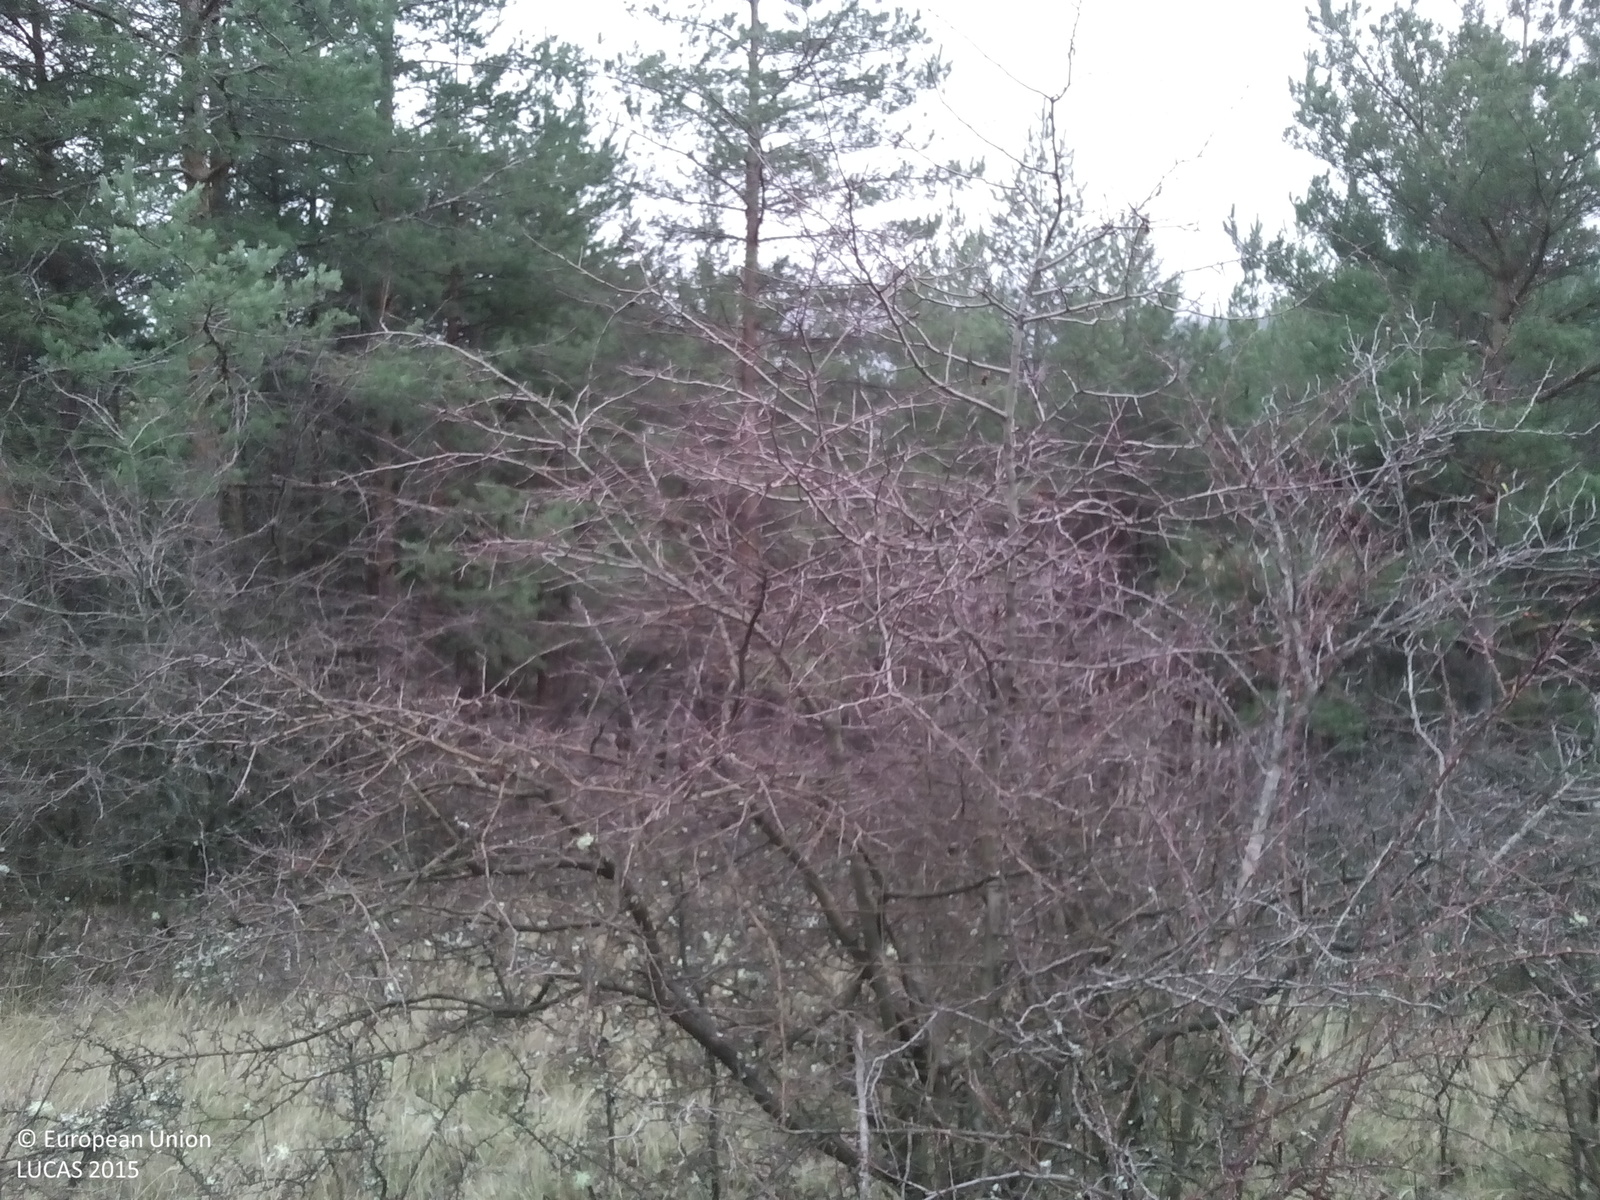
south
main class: Shrubland
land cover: Shrubland with sparse tree cover
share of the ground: 25 - 50 %
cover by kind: herbaceous plants 55 %, shrubs 40 %, coniferous forest trees 5 %
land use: Semi-natural and natural areas not in use
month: December
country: BG
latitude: 42.7959
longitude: 22.8789
